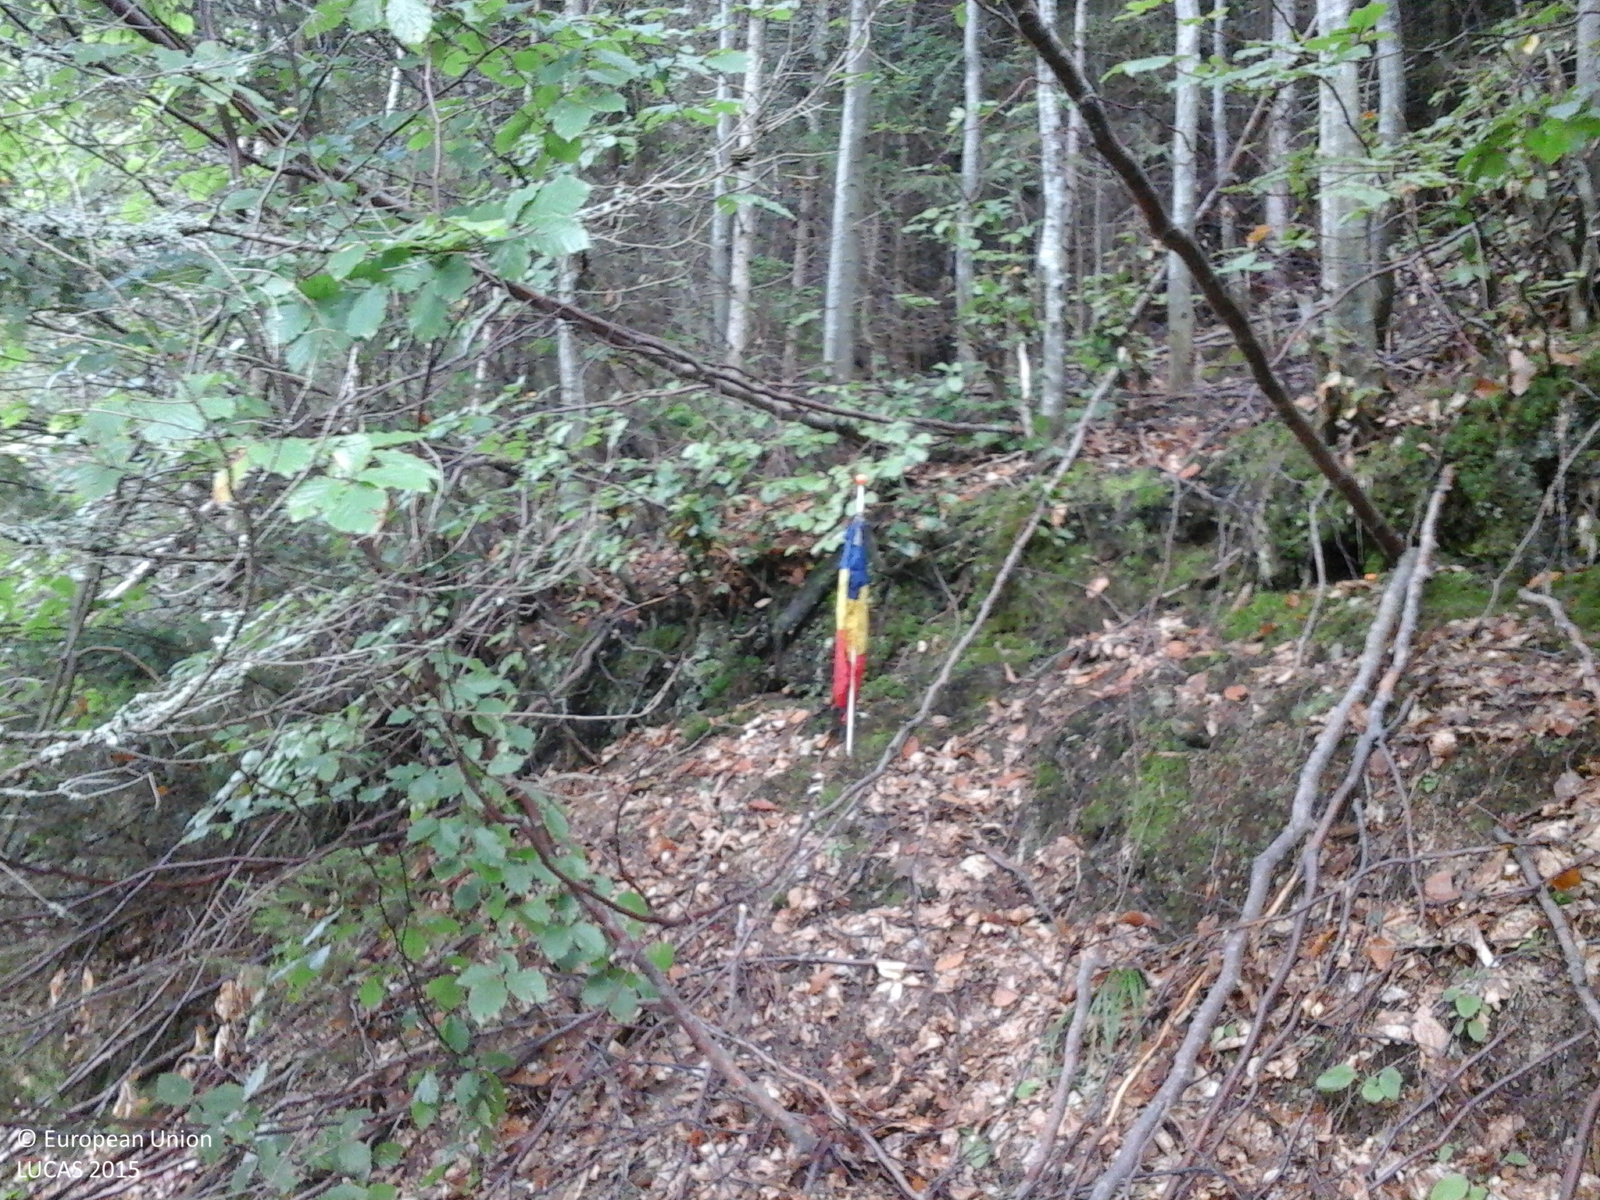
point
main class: Woodland
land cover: Spruce dominated mixed woodland
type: alpine coniferous forest
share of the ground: > 75 %
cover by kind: coniferous forest trees 60 %, broadleaved forest trees 40 %
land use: Forestry
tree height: > 5 m
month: September
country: RO
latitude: 45.2731
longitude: 22.9112
